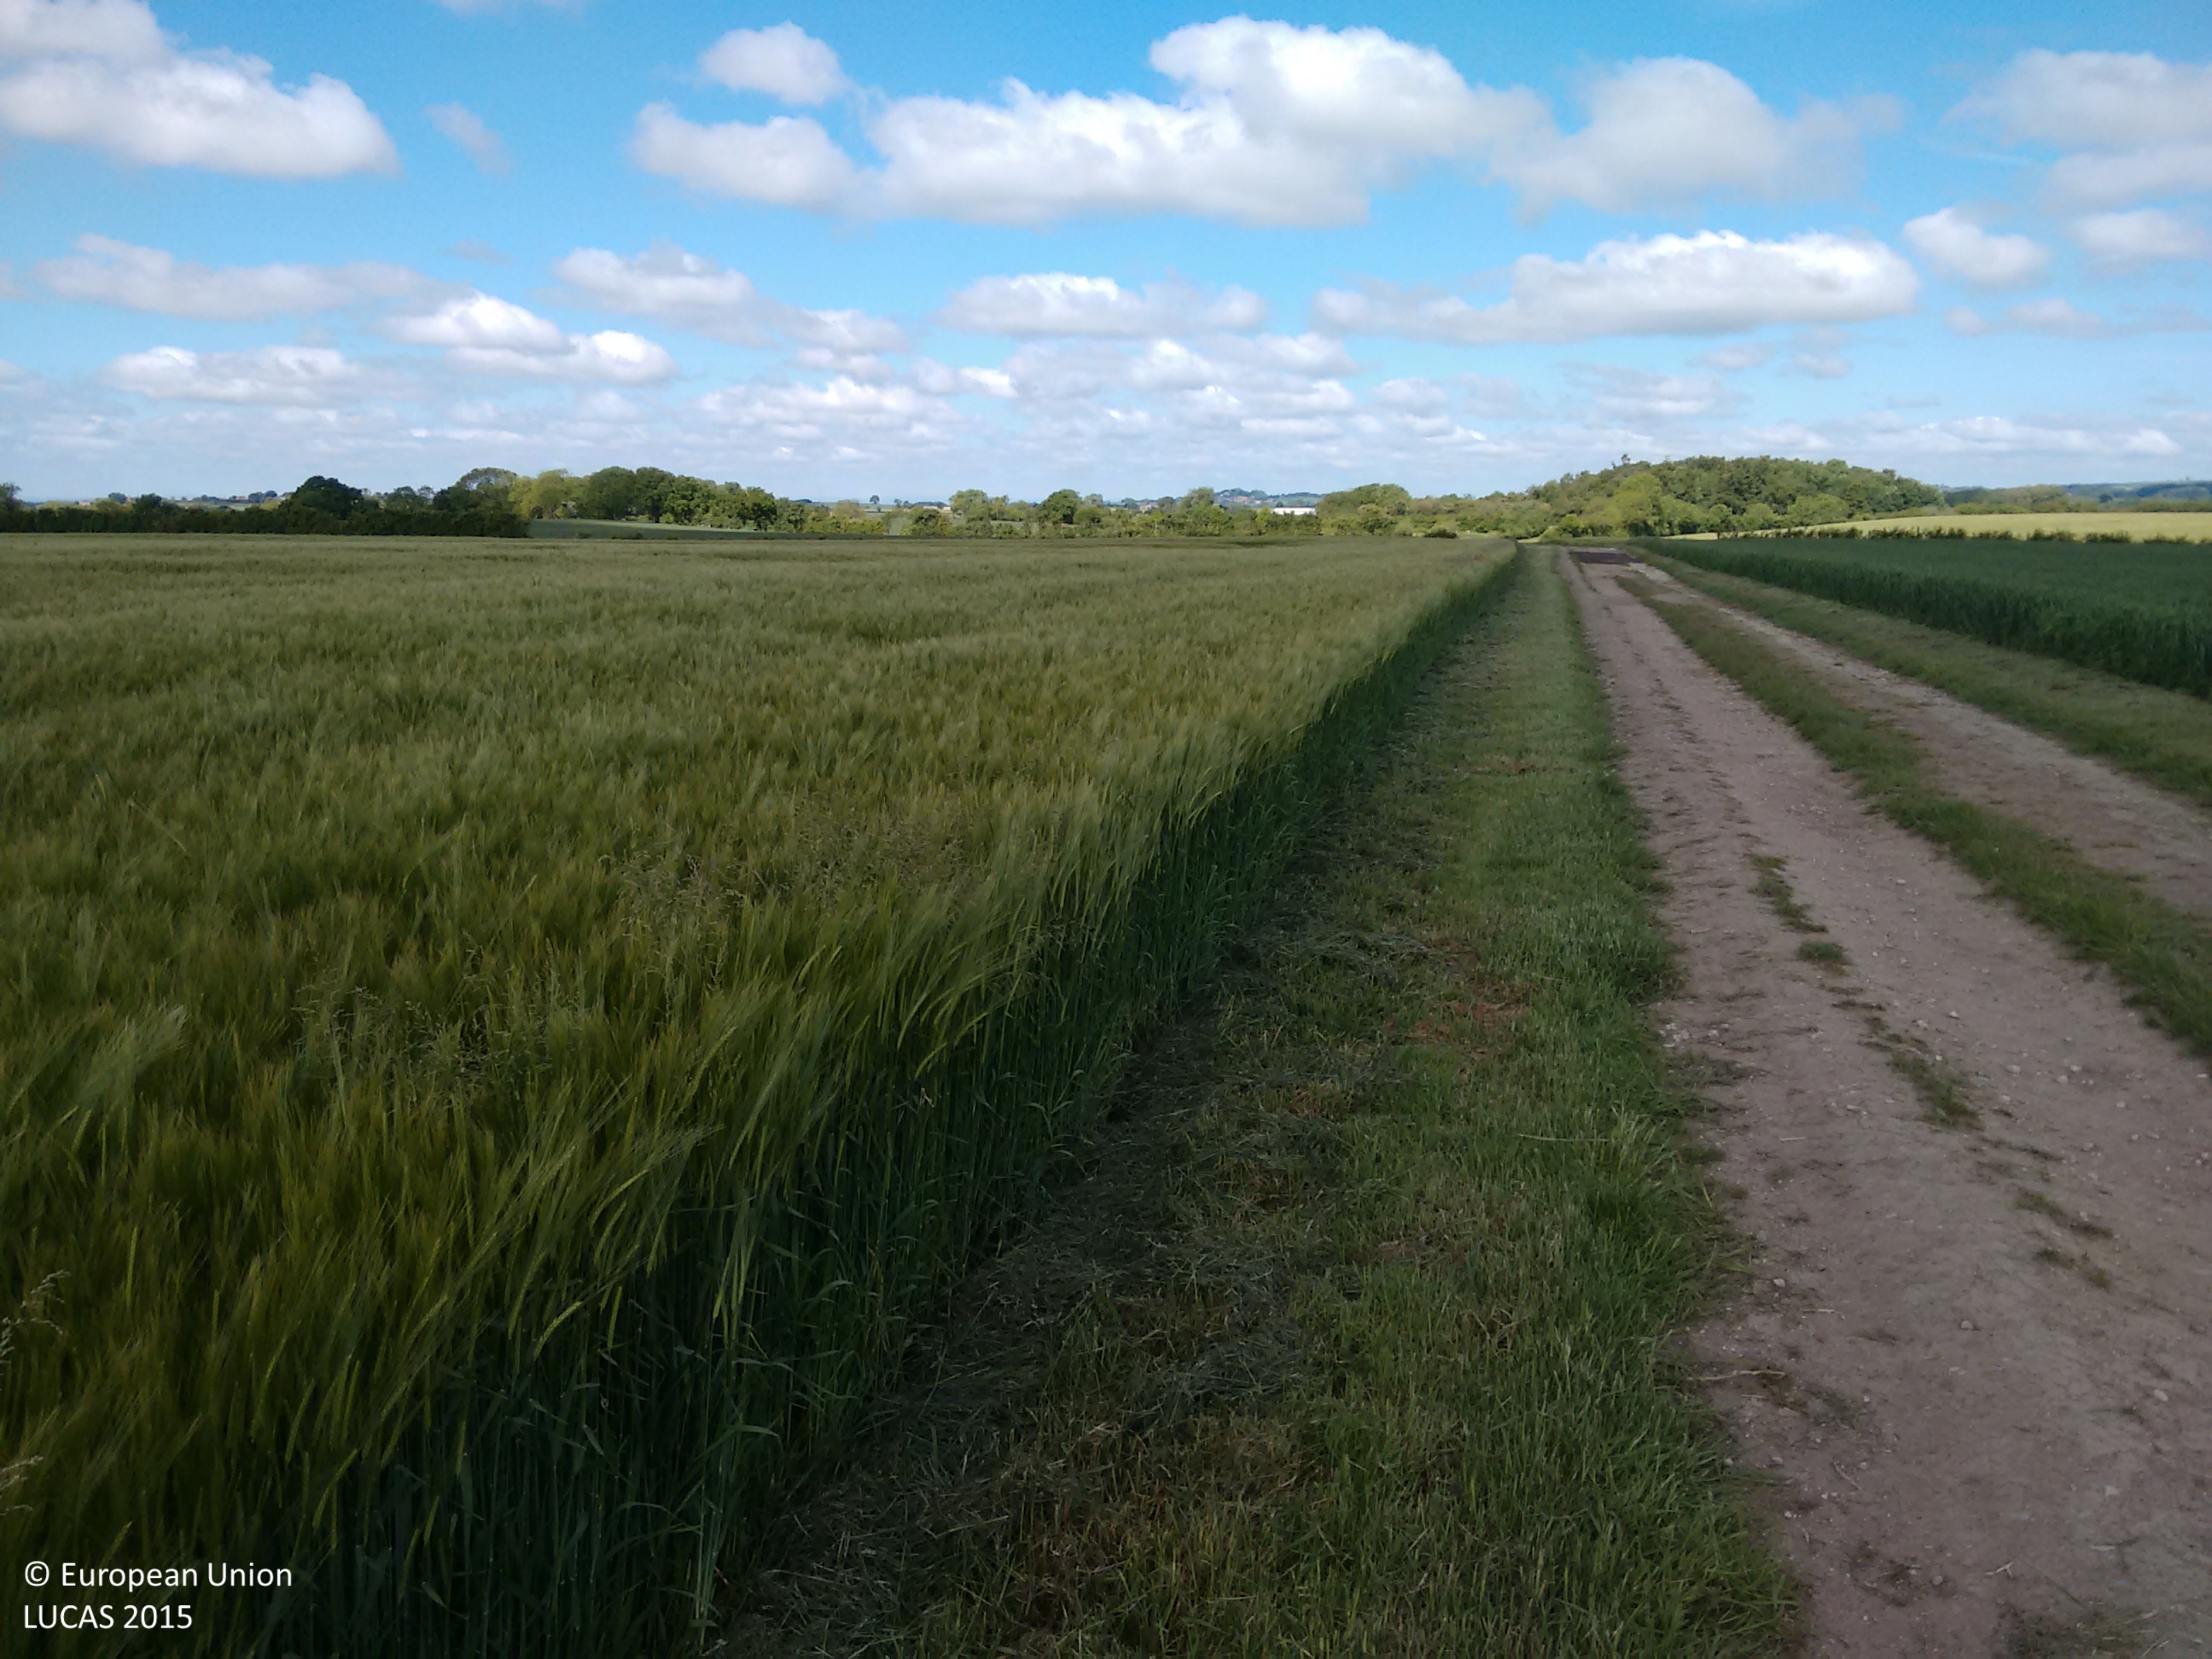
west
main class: Cropland
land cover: Barley
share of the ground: > 75 %
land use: Agriculture (excluding fallow land and kitchen gardens)
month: June
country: GB
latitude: 54.1117
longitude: -1.0413
